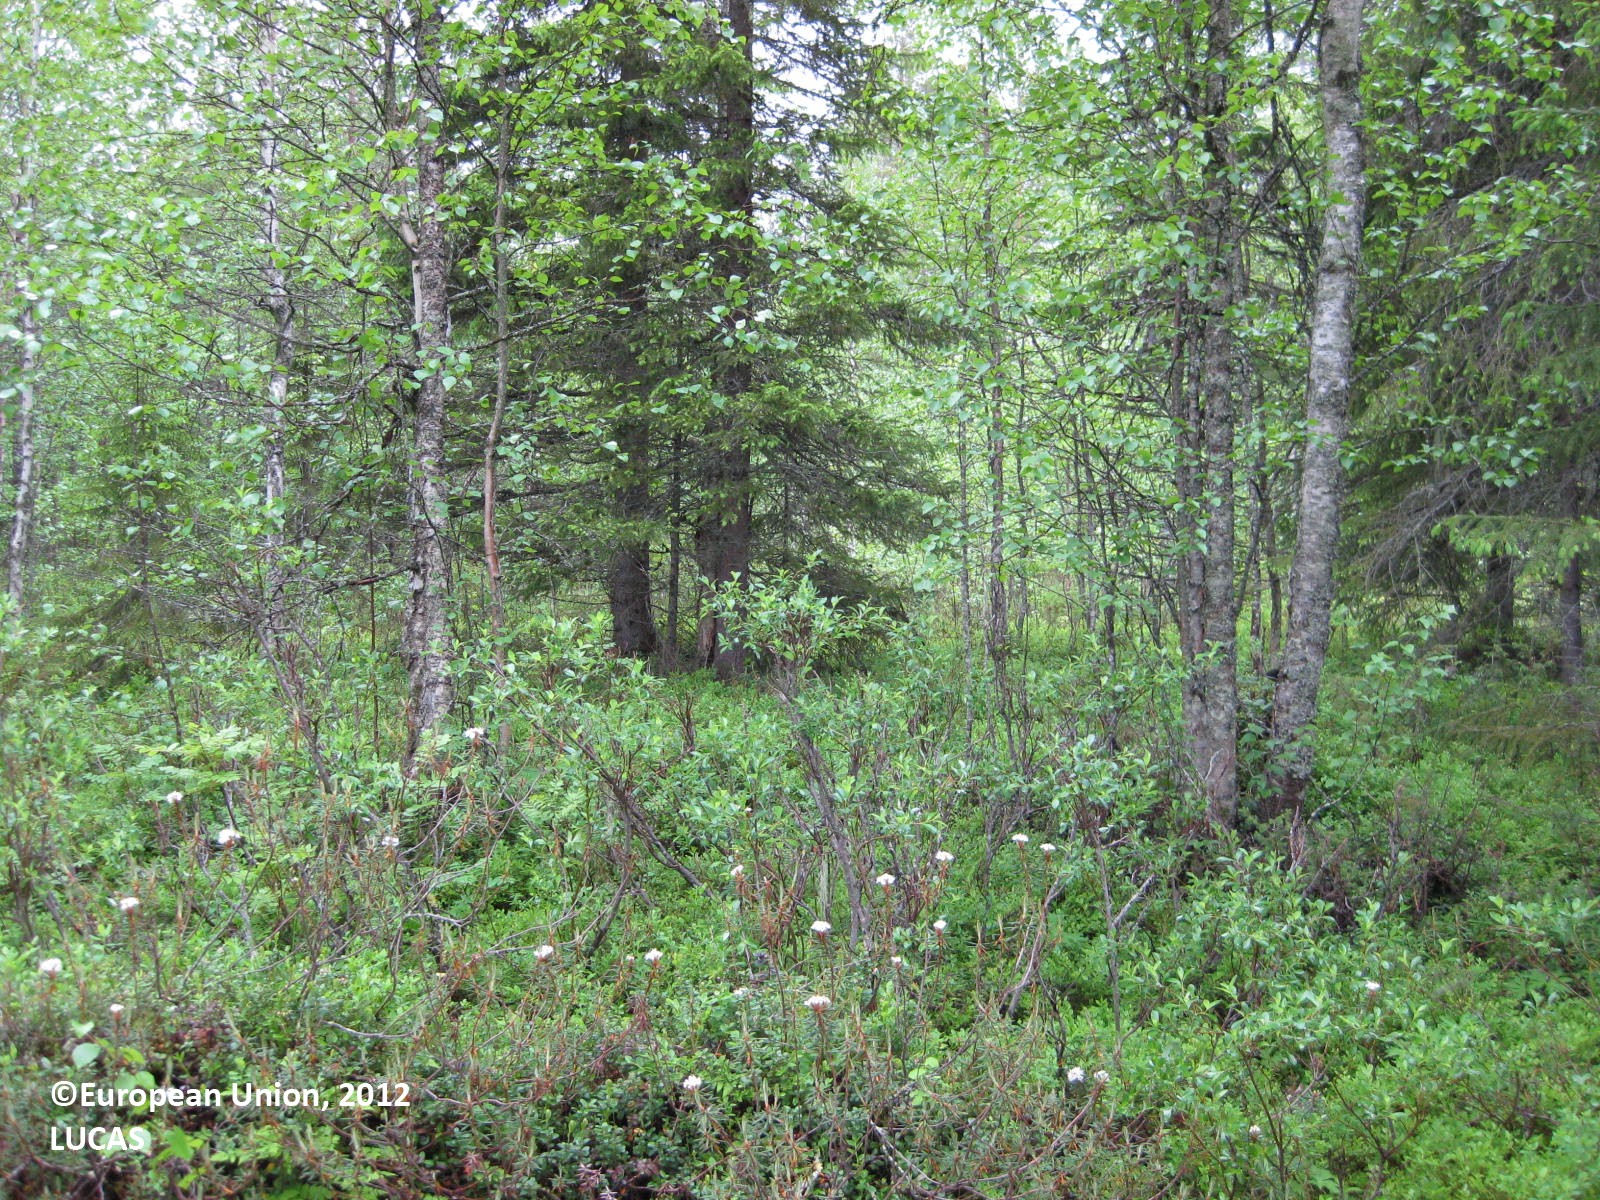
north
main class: Woodland
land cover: Spruce dominated mixed woodland
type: boreal forest
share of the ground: 50 - 75 %
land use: Forestry
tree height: > 5 m
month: June
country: FI
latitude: 65.2390
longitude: 29.1252
